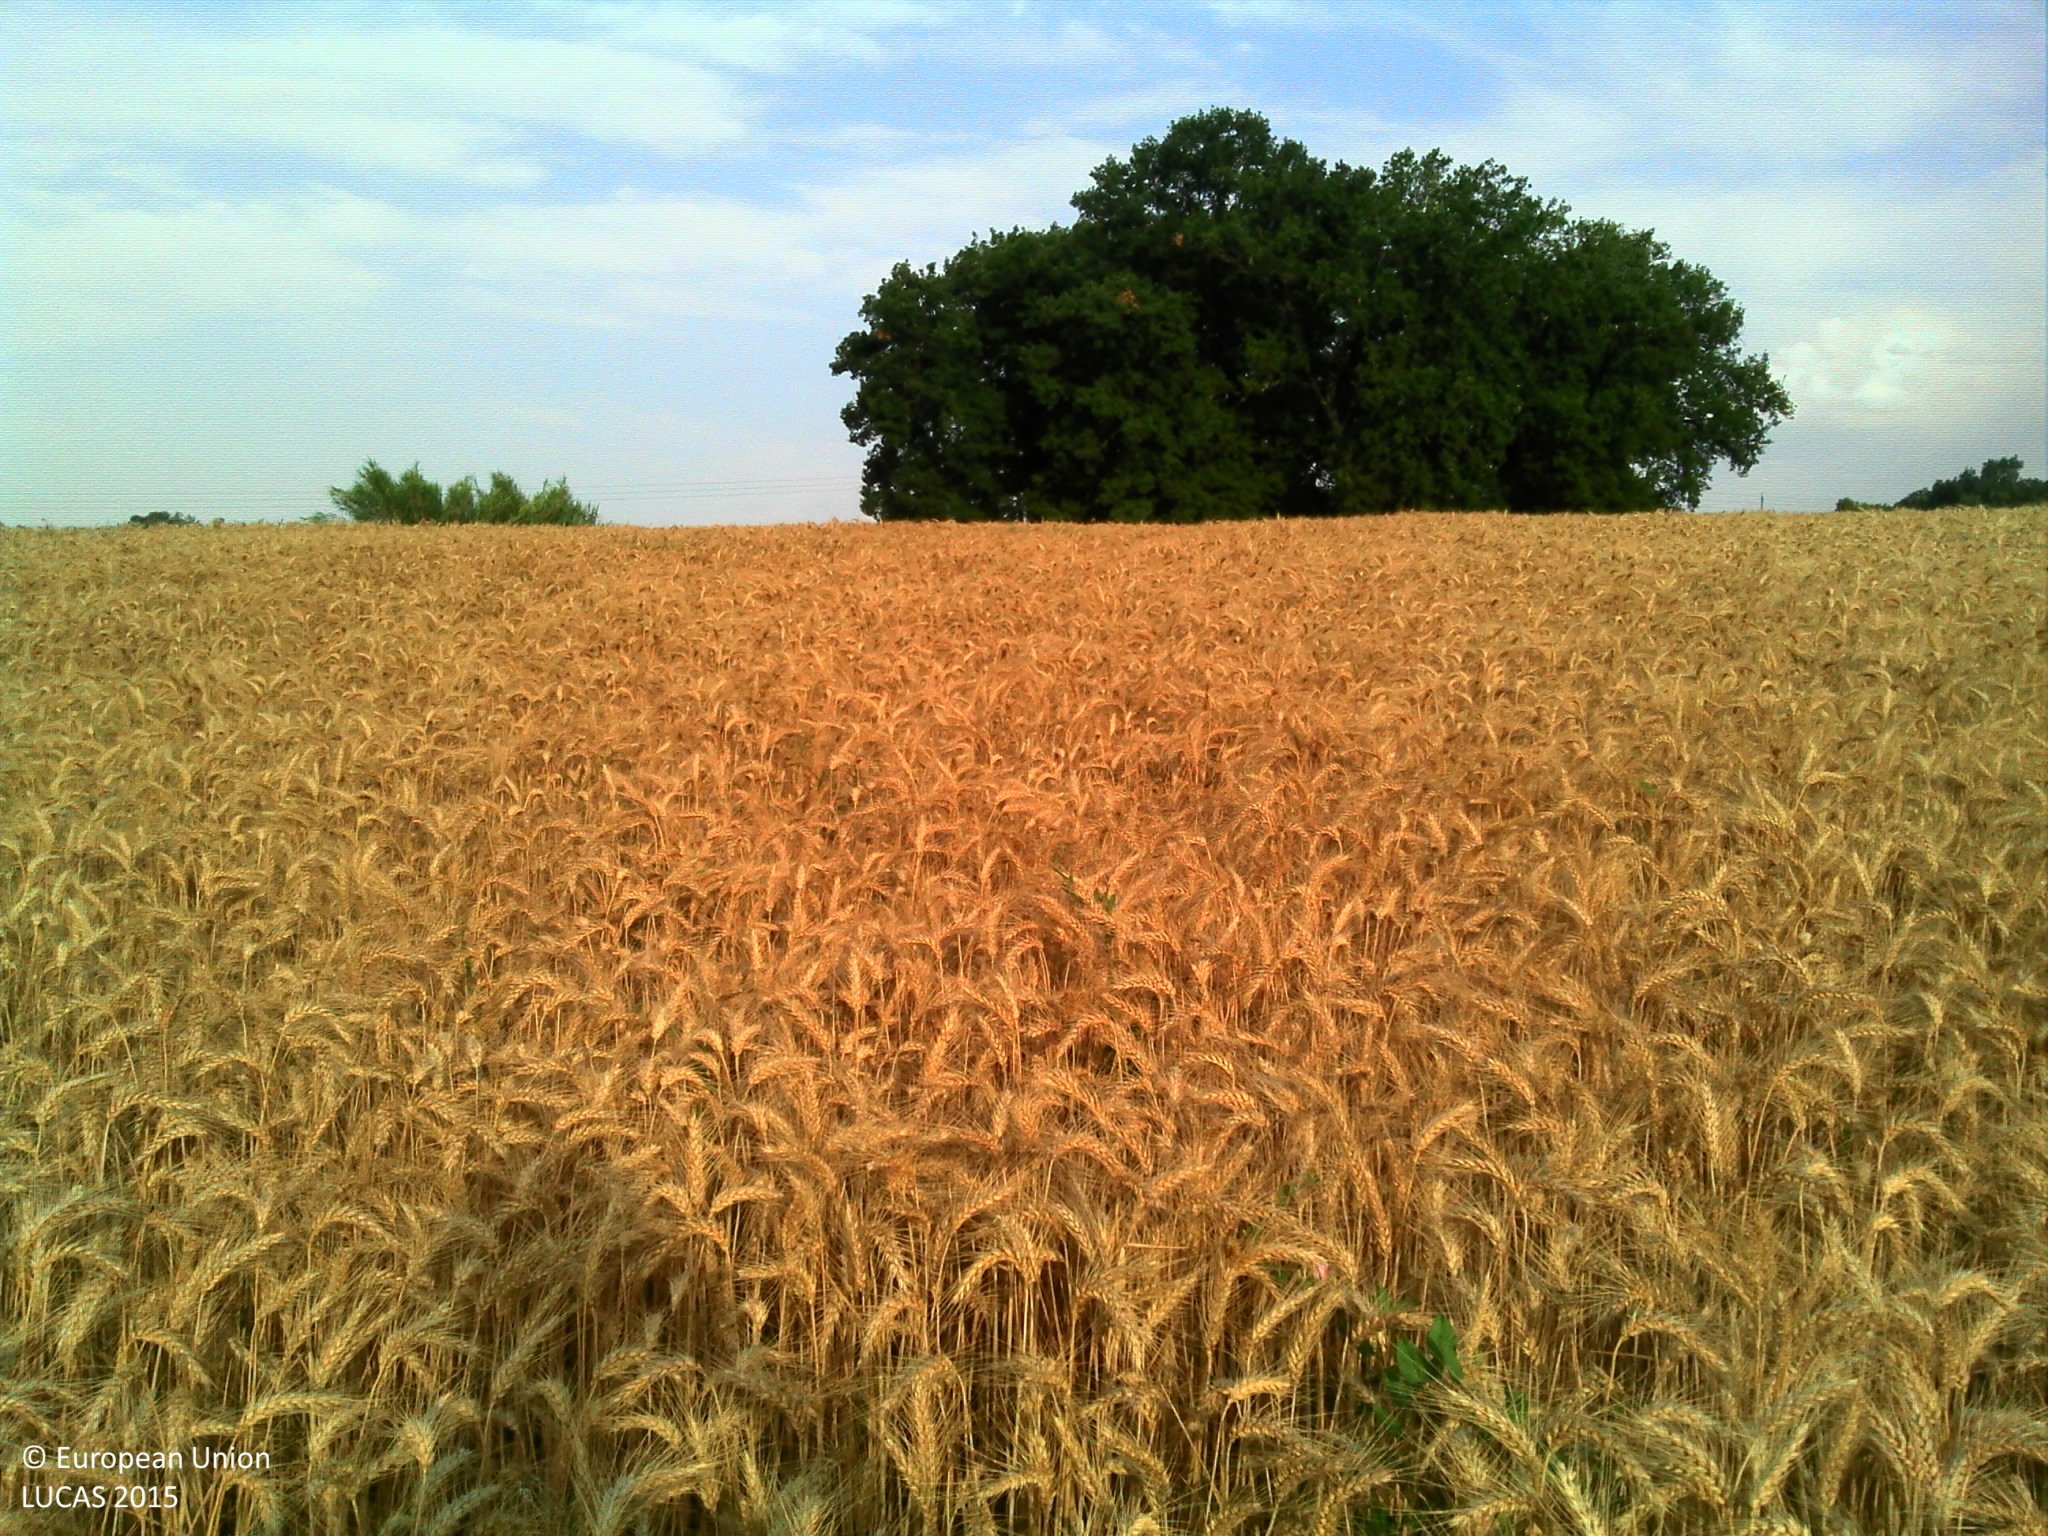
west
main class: Cropland
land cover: Common wheat
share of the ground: > 75 %
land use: Agriculture (excluding fallow land and kitchen gardens)
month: July
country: FR
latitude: 44.5035
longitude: 0.7999
